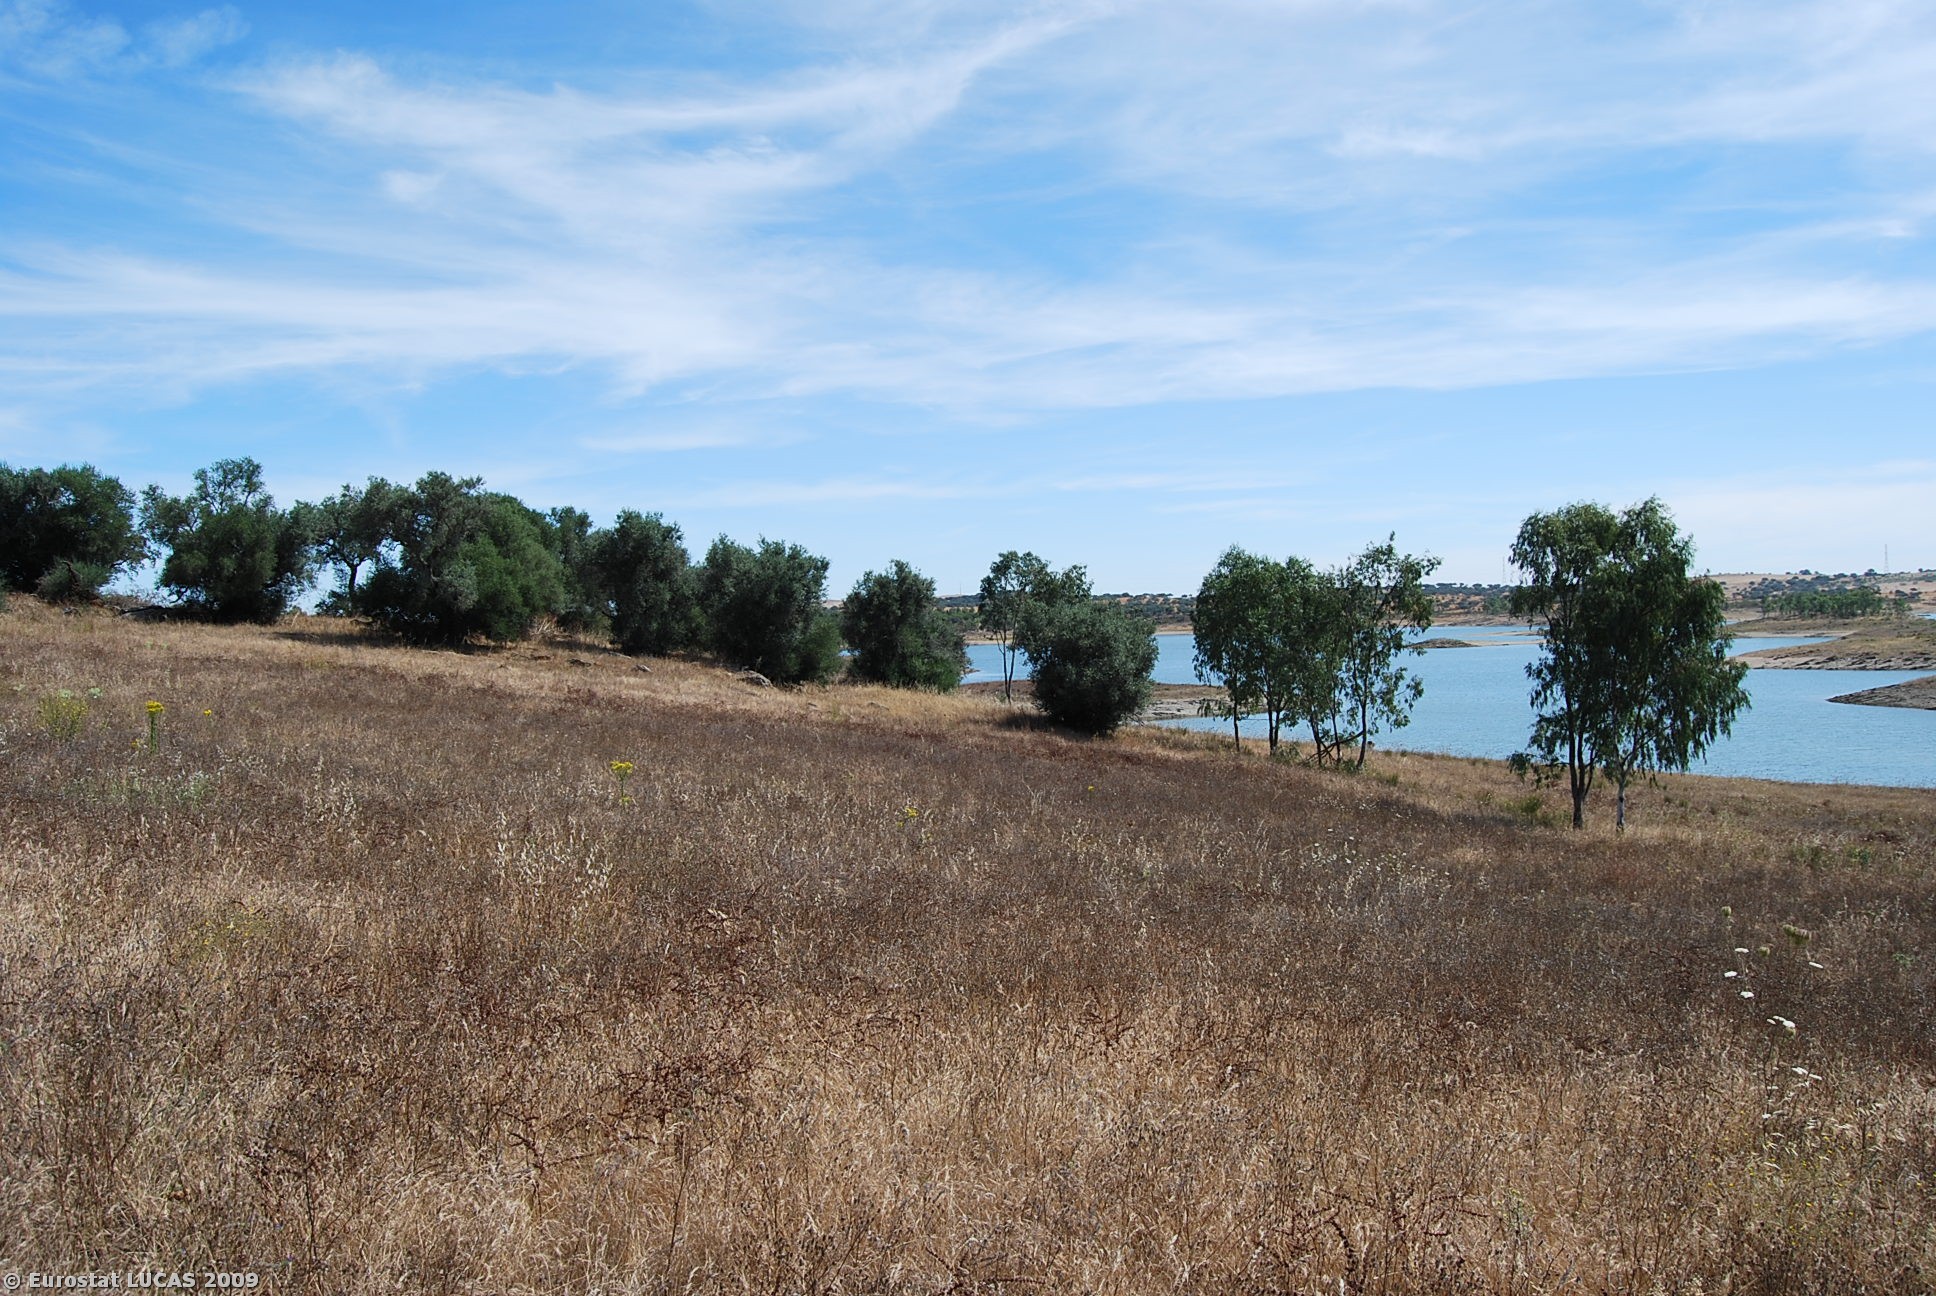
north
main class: Grassland
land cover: Grassland with sparse tree/shrub cover
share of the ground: 50 - 75 %
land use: Fallow land
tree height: > 5 m
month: July
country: PT
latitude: 37.7180
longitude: -8.2852
